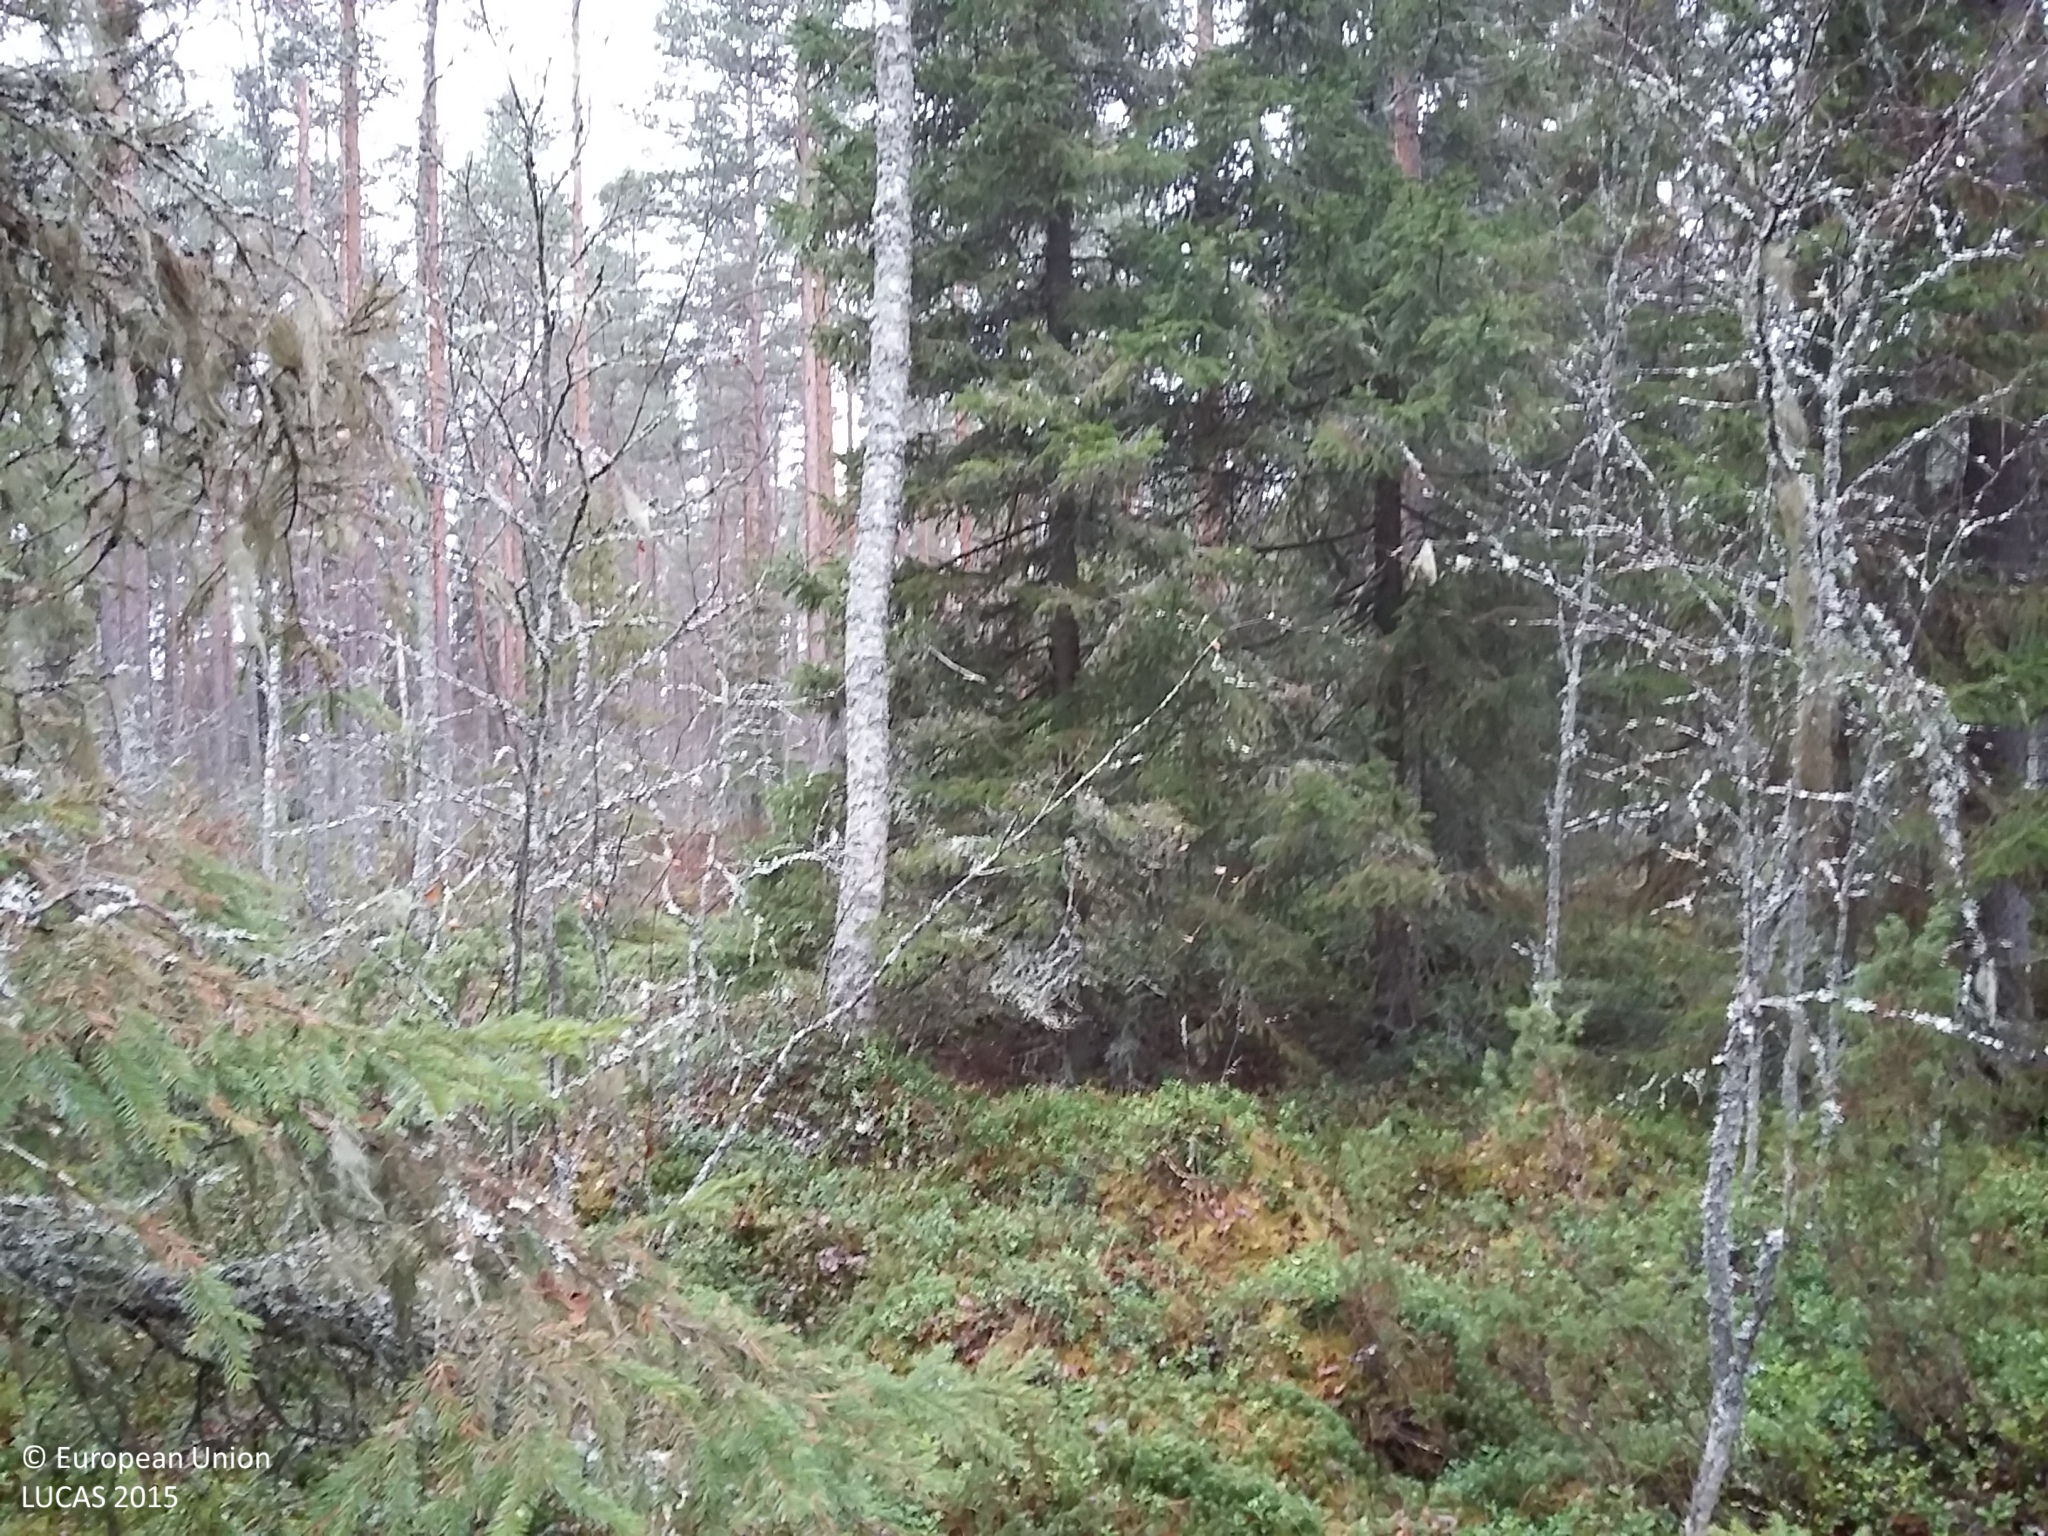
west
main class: Woodland
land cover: Other mixed woodland
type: boreal forest
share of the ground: > 75 %
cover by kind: coniferous forest trees 50 %, broadleaved forest trees 35 %, lichens and mosses 15 %
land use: Forestry
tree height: > 5 m
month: October
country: FI
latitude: 64.3591
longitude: 25.2260
